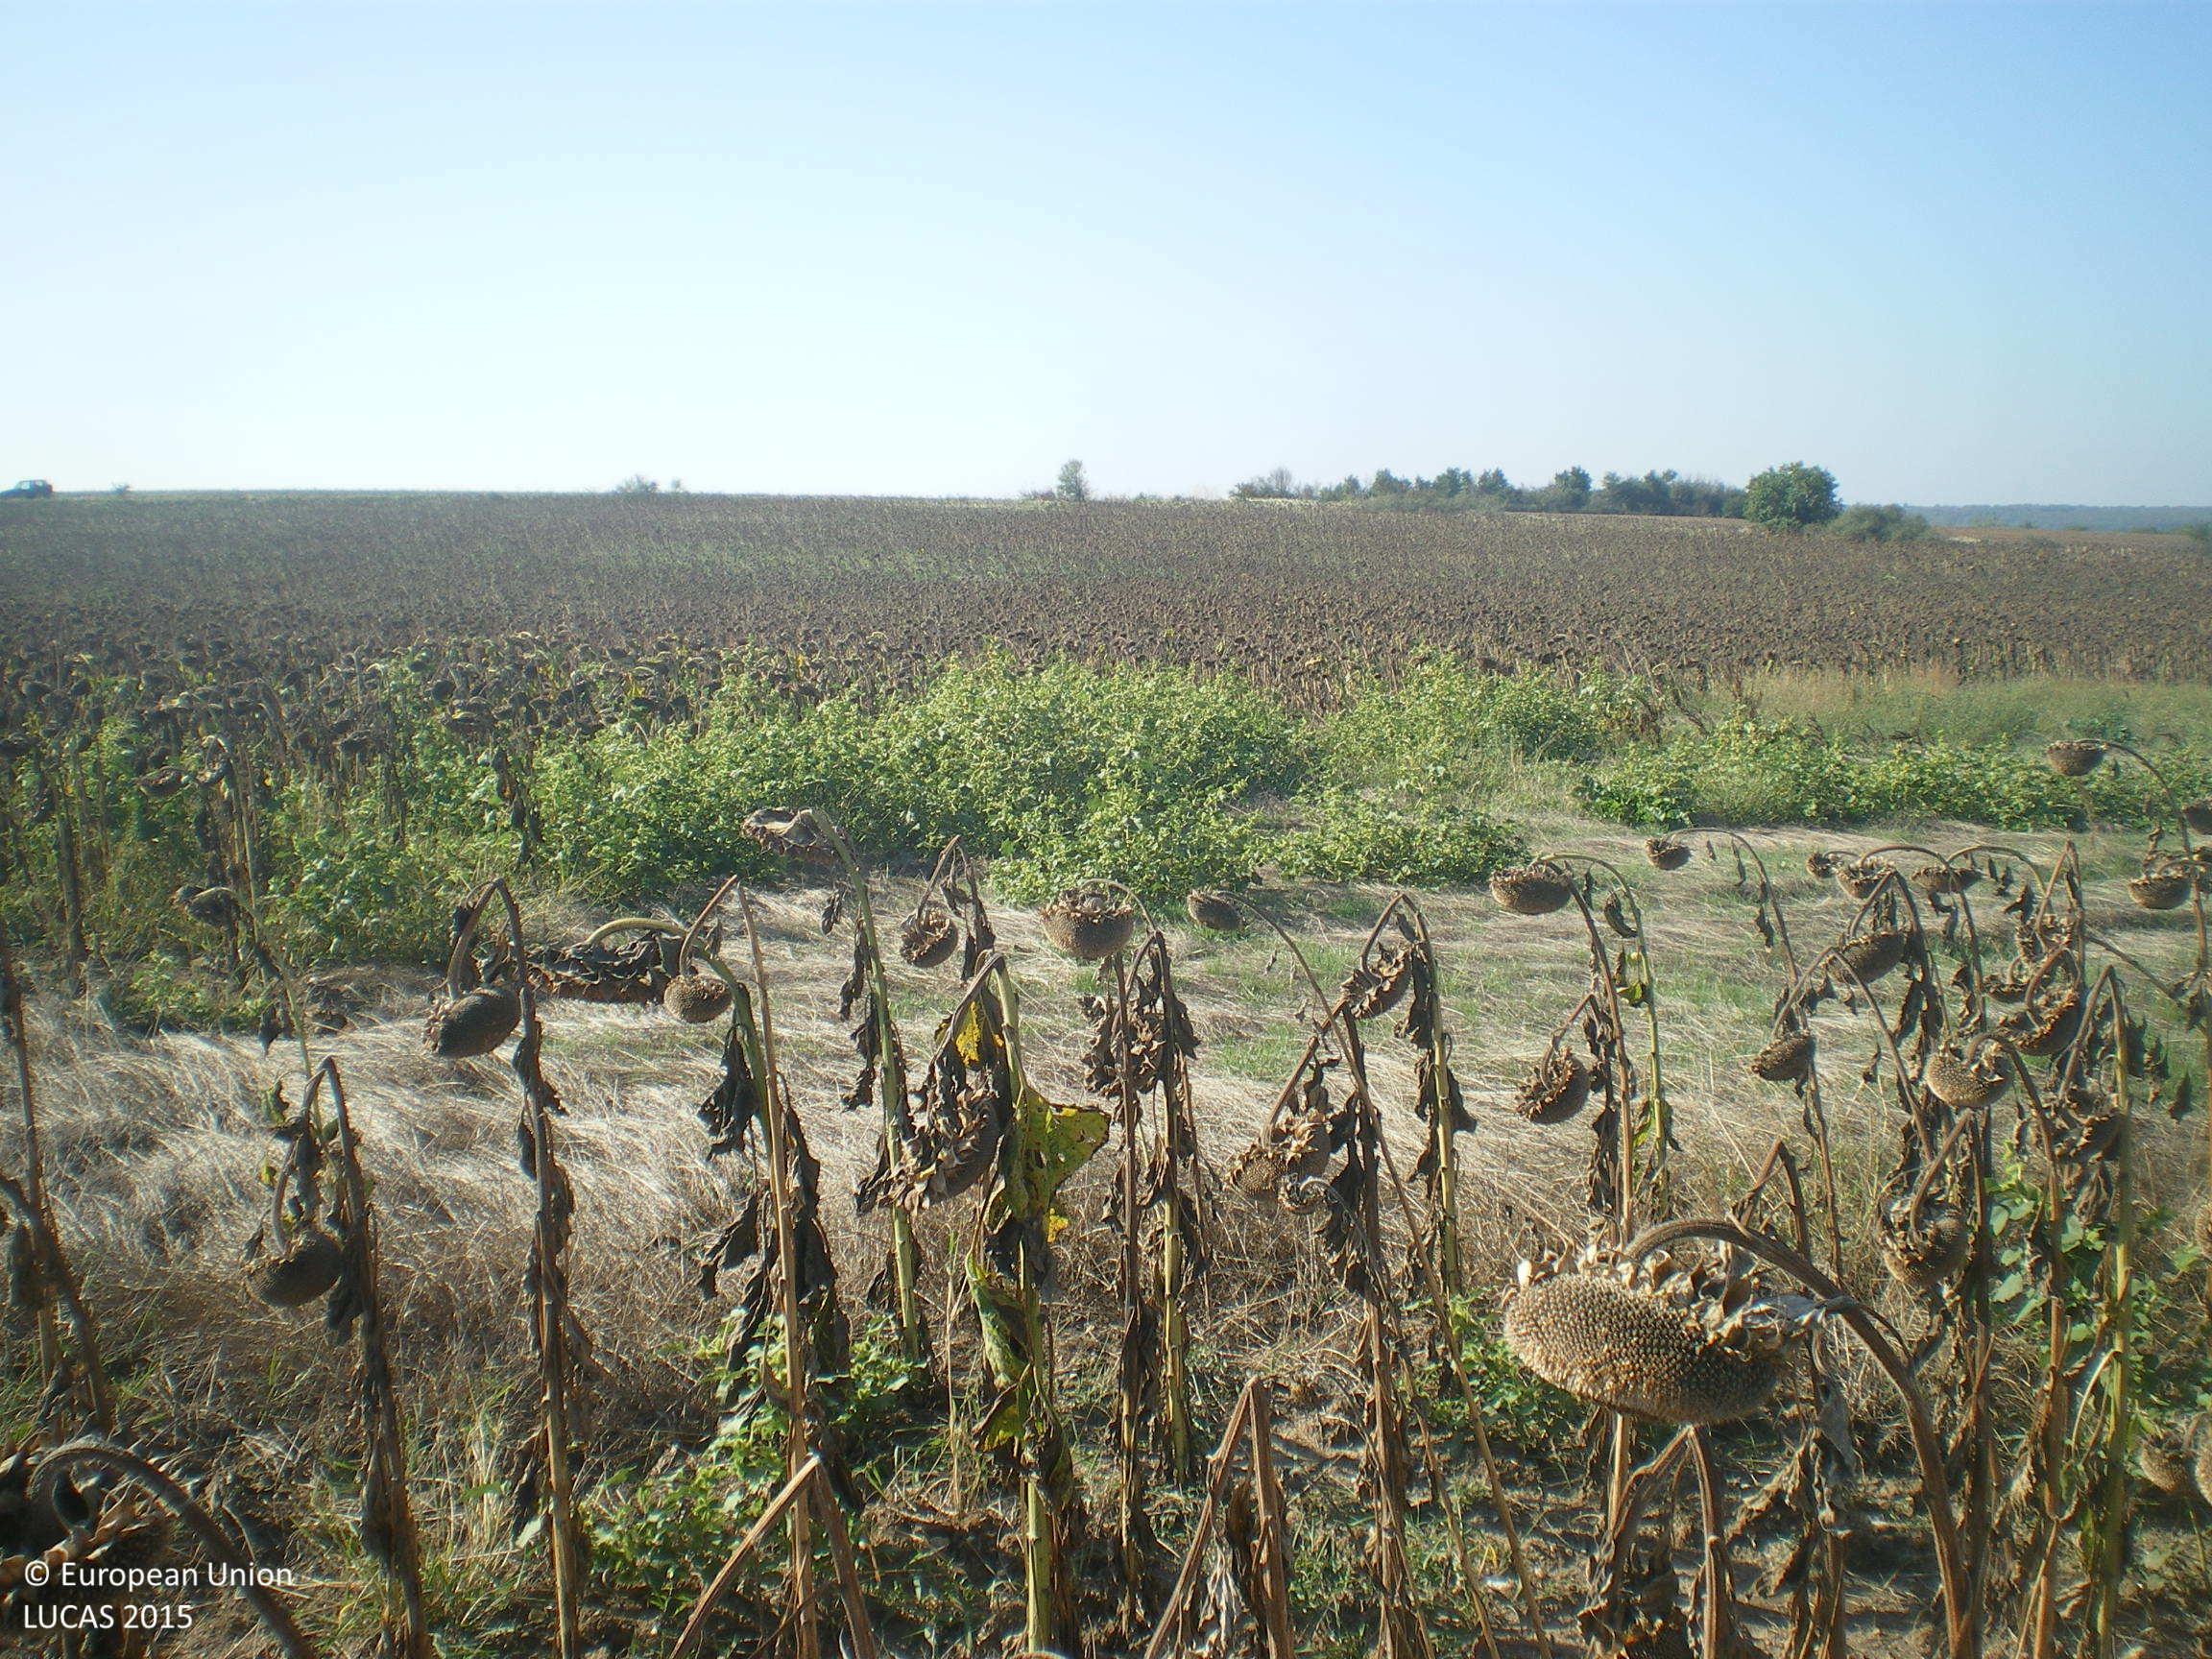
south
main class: Cropland
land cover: Sunflower
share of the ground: > 75 %
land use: Agriculture (excluding fallow land and kitchen gardens)
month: September
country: BG
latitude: 41.9837
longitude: 25.6242
